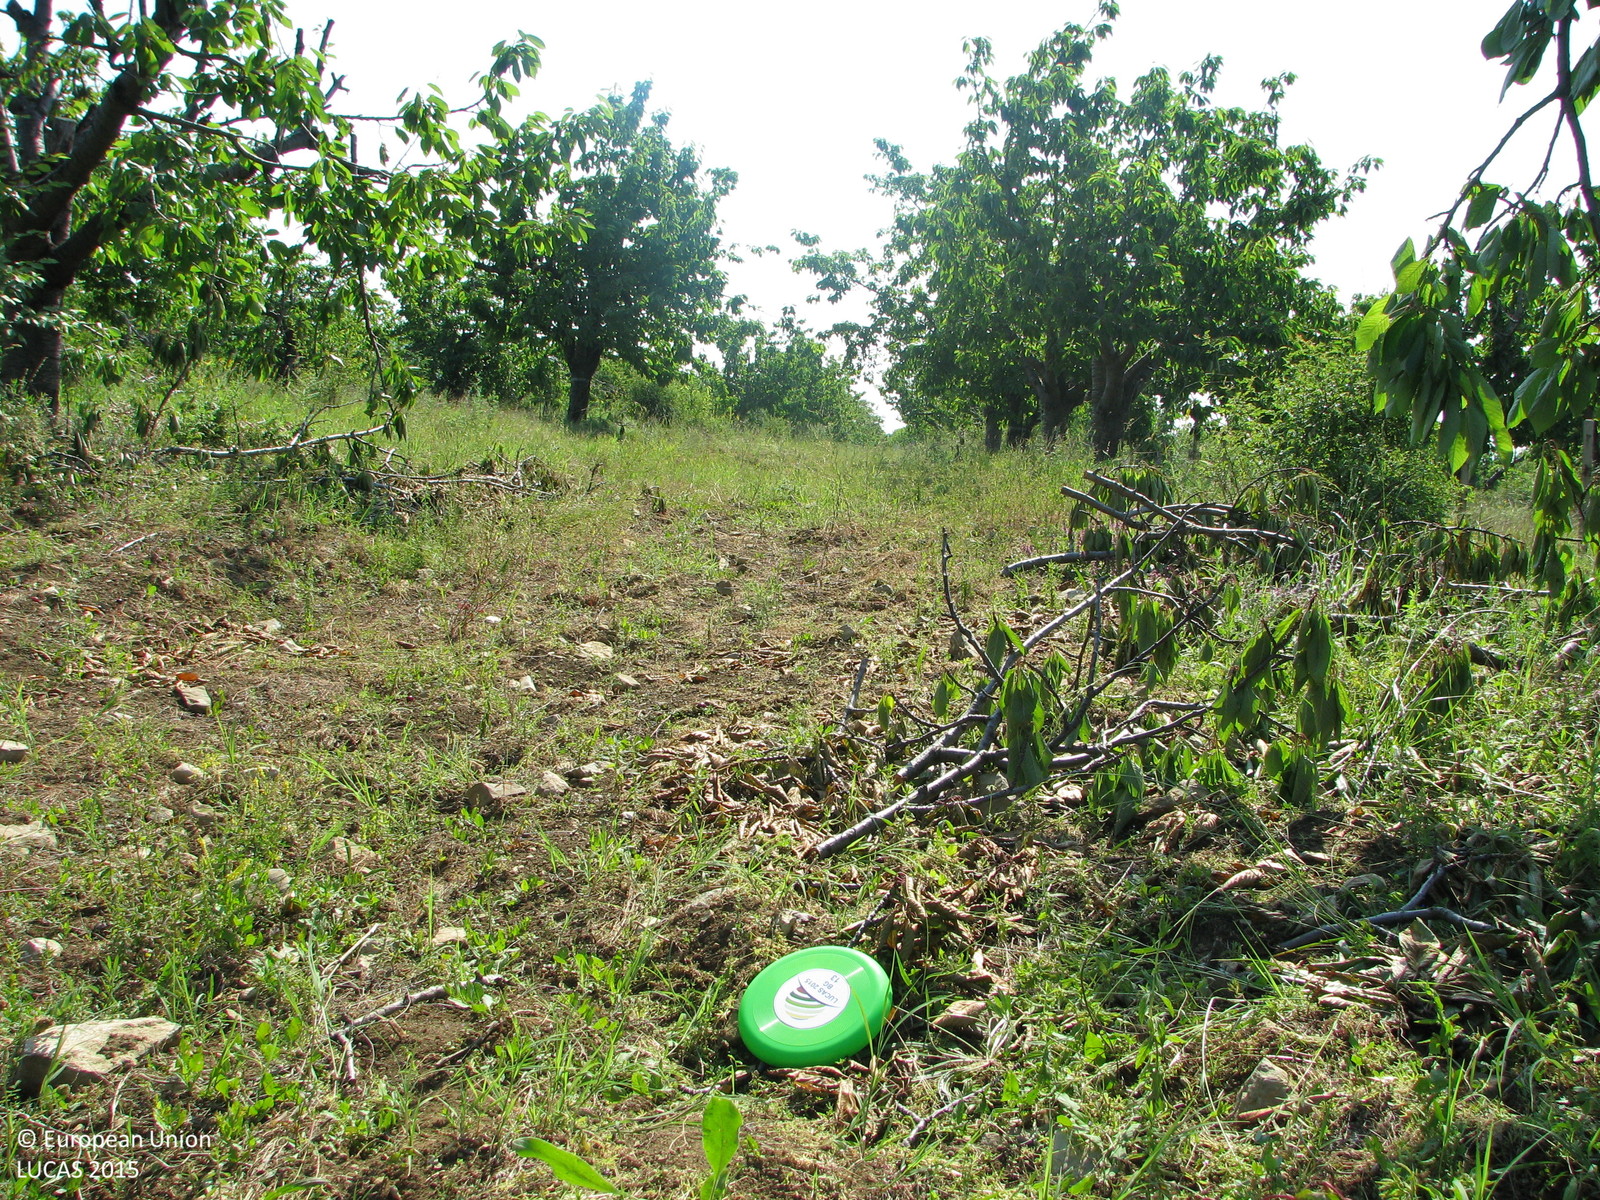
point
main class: Cropland
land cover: Cherry fruit
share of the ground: 25 - 50 %
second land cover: Spontaneously vegetated surfaces
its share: > 75 %
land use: Agriculture (excluding fallow land and kitchen gardens)
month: June
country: BG
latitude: 42.6449
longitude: 26.1990
